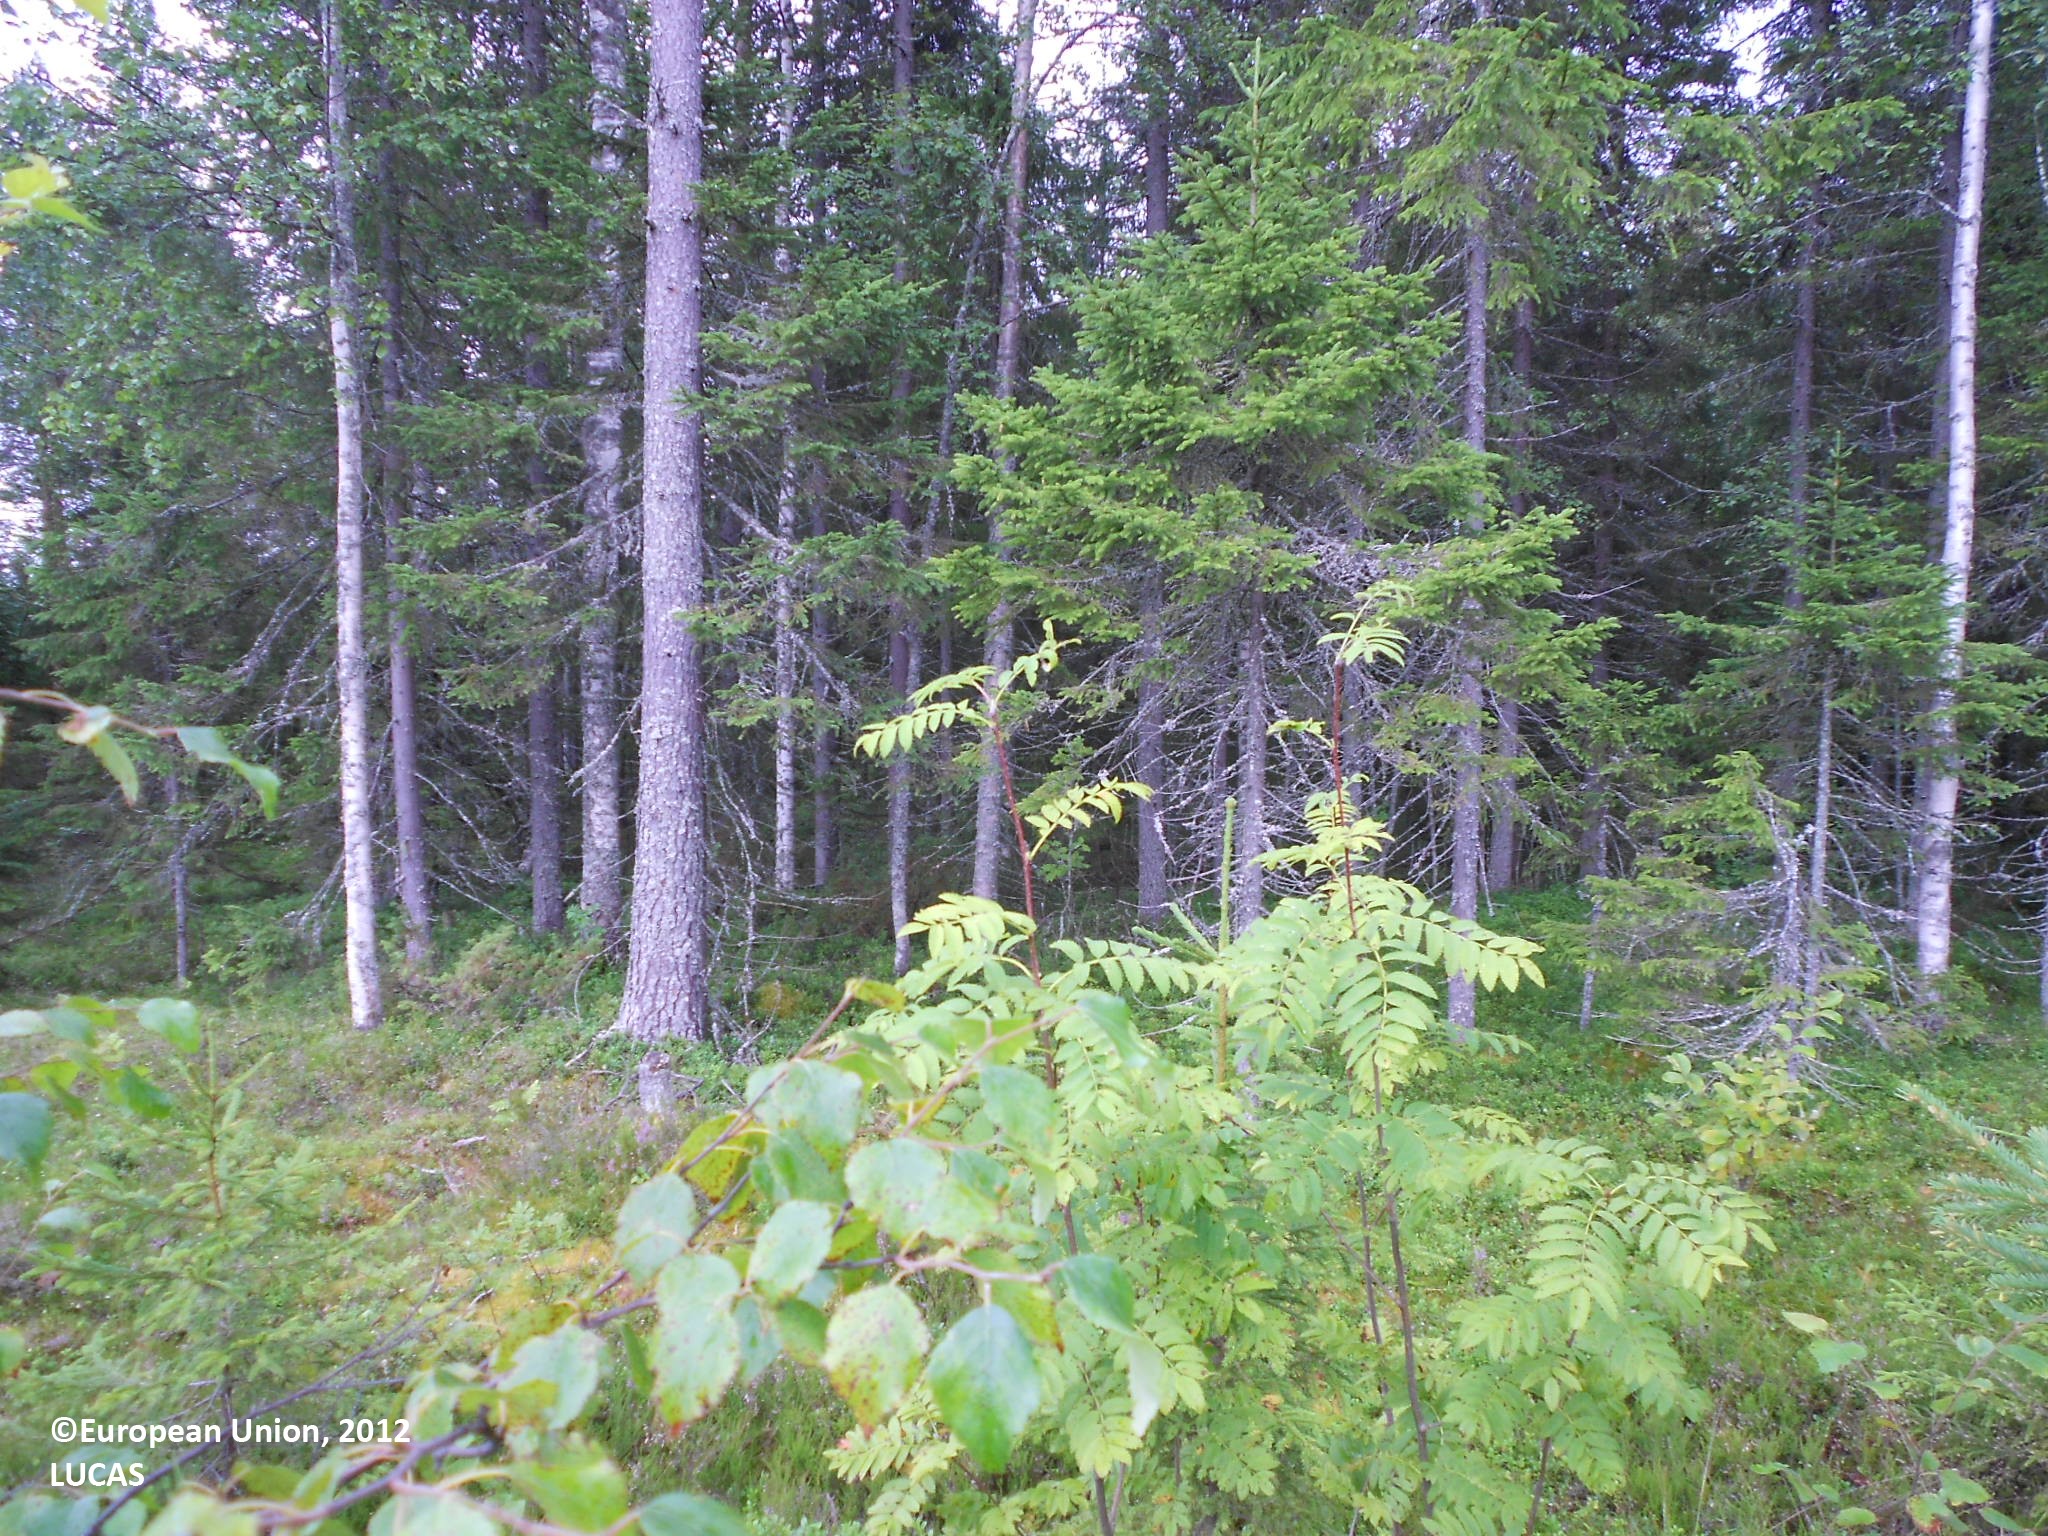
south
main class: Woodland
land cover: Spruce dominated mixed woodland
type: boreal forest
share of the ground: 50 - 75 %
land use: Forestry
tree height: < 5 m
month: August
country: FI
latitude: 63.3764
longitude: 28.7409
